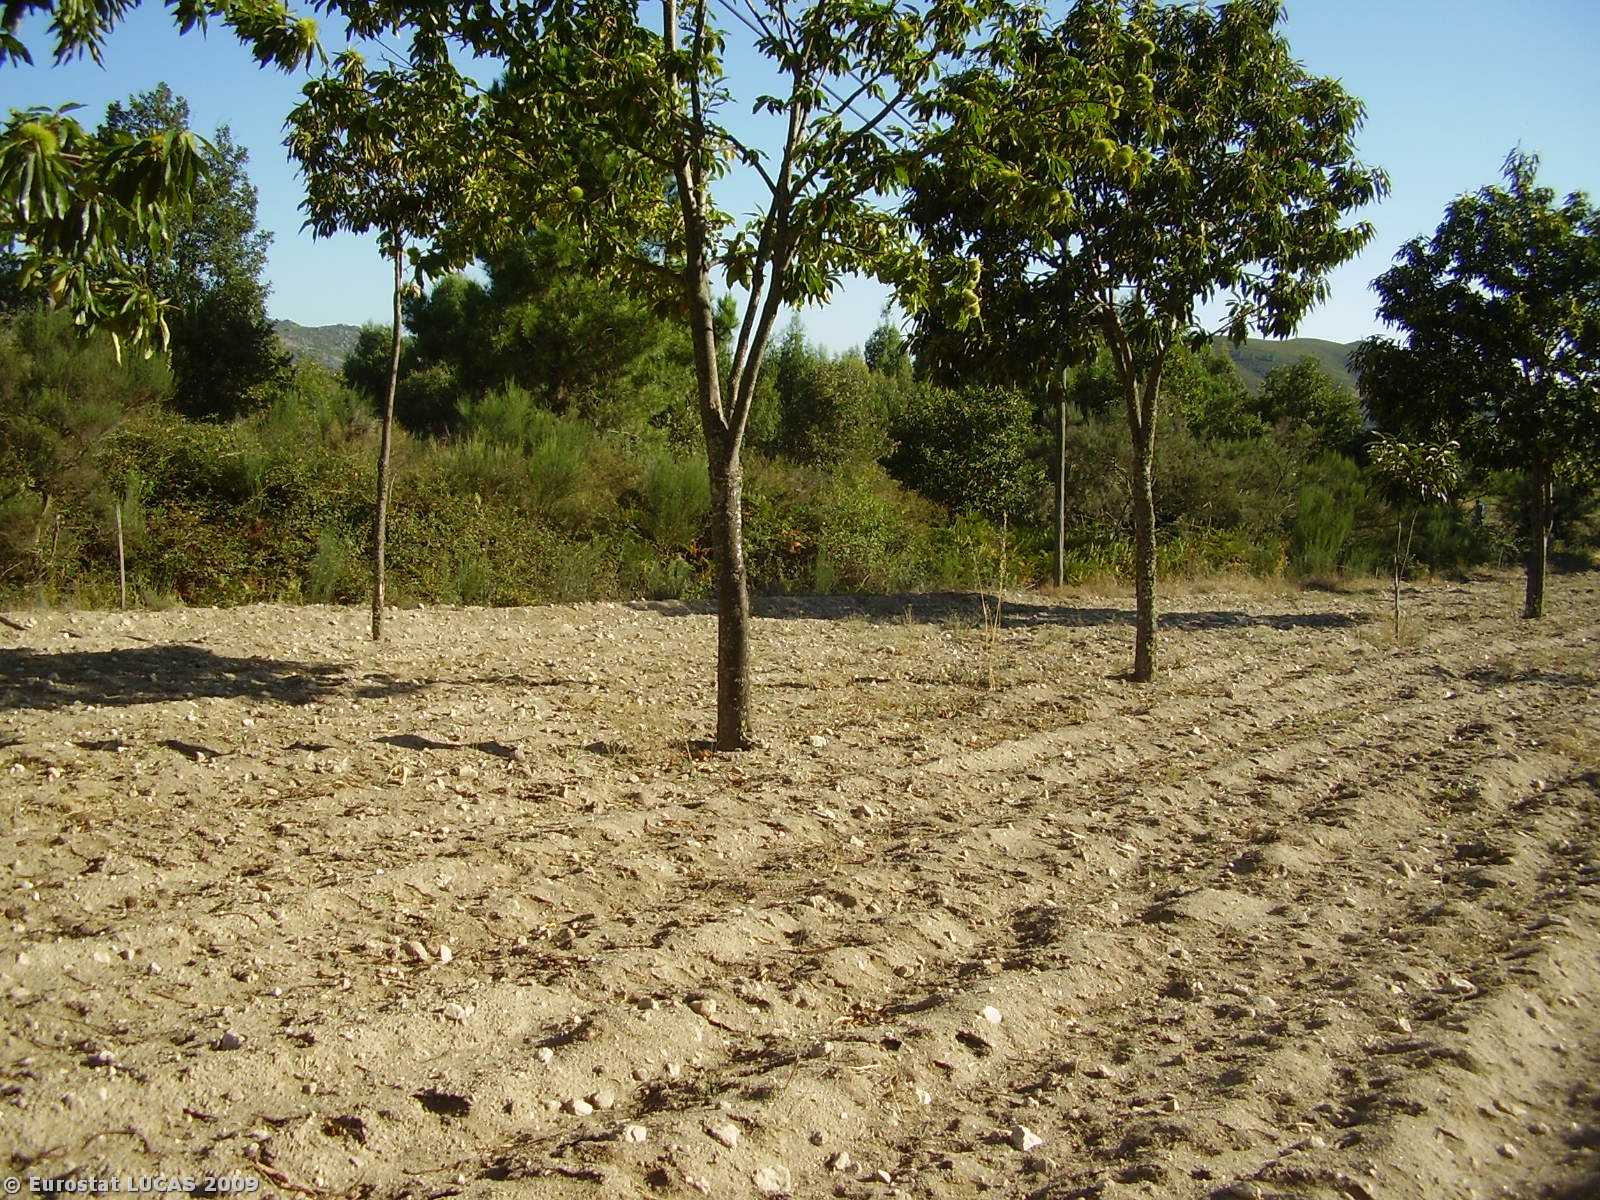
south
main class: Cropland
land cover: Other fruit trees and berries
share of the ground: 10 - 25 %
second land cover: Spontaneously vegetated surfaces
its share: 10 - 25 %
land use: Agriculture (excluding fallow land and kitchen gardens)
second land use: Fallow land
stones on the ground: 25 - 50 %
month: September
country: PT
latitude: 41.7213
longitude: -7.6237
